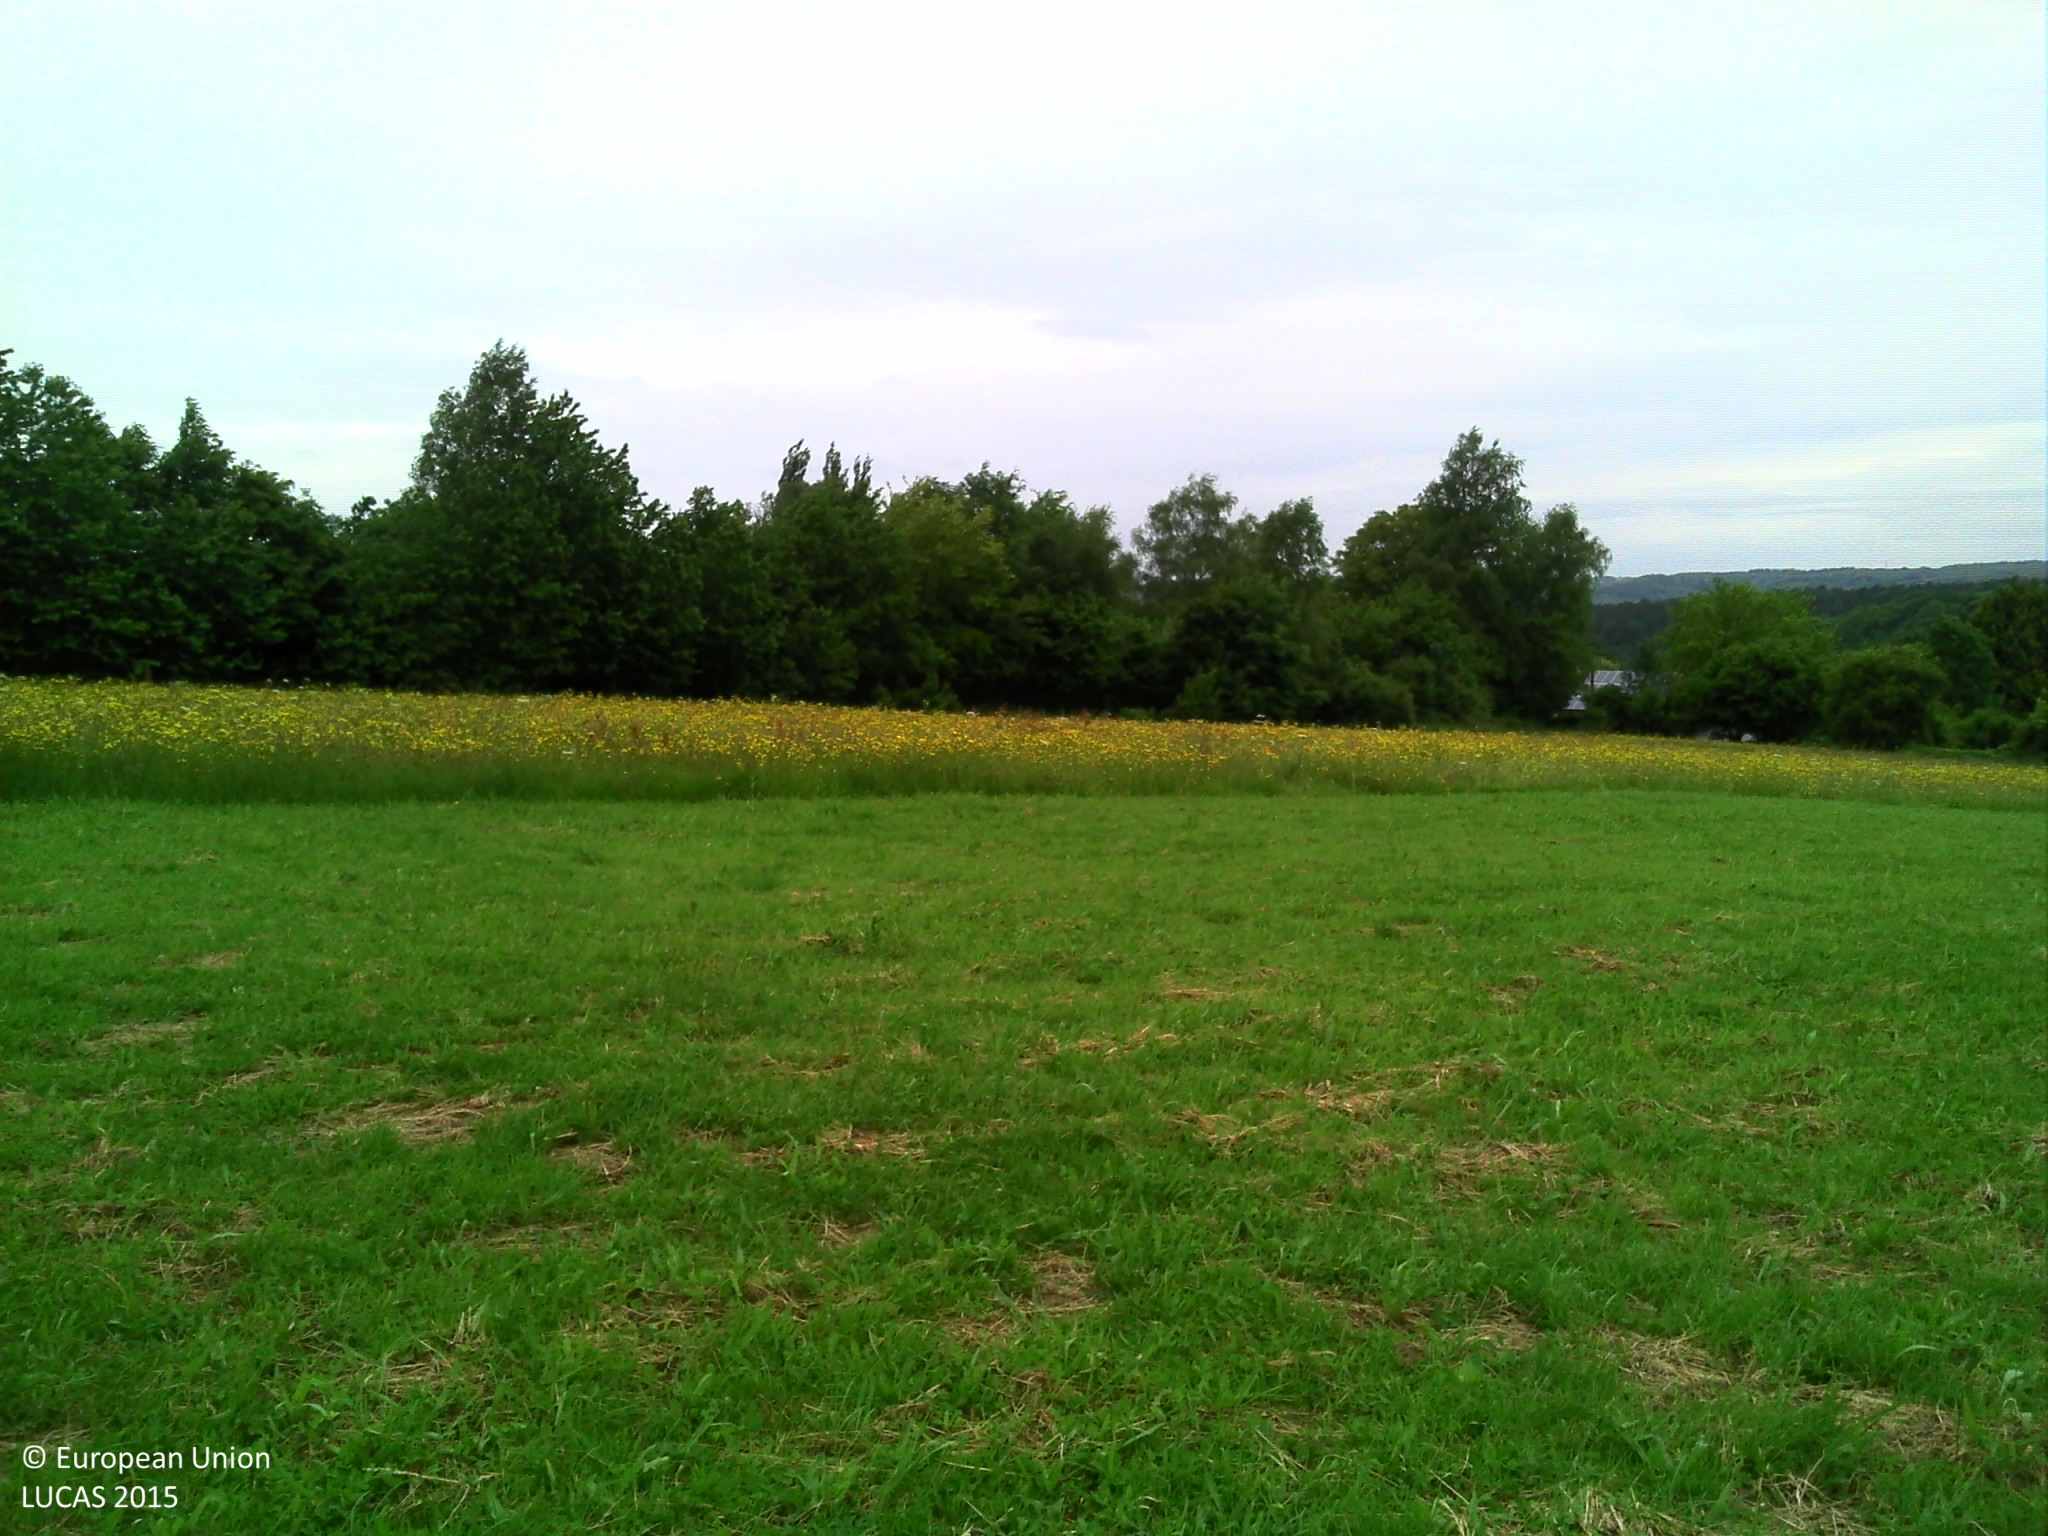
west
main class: Grassland
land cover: Grassland without tree/shrub cover
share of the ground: > 75 %
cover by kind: herbaceous plants 100 %
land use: Agriculture (excluding fallow land and kitchen gardens)
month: June
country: BE
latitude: 50.4222
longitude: 5.5647
